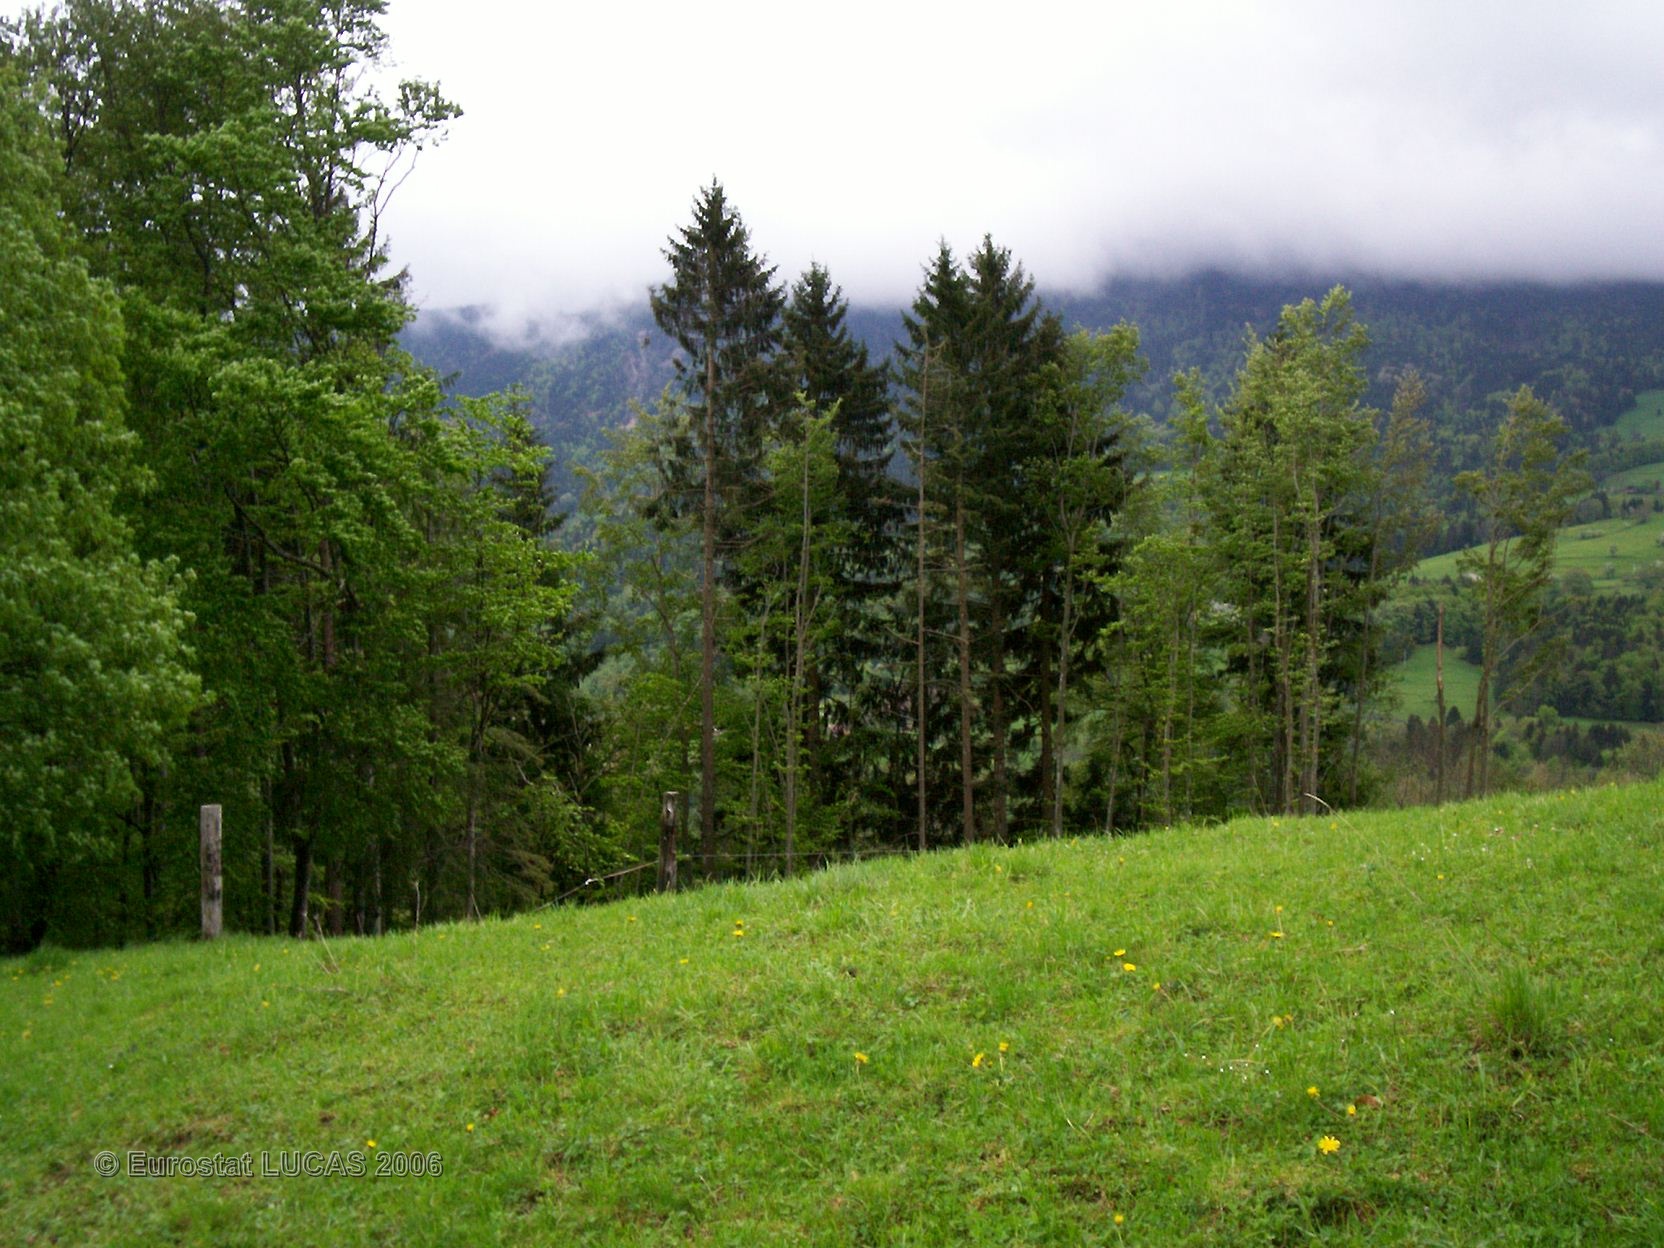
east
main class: Grassland
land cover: Grassland without tree/shrub cover
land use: Agriculture (excluding fallow land and kitchen gardens)
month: May
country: FR
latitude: 45.7944
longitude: 6.1318
